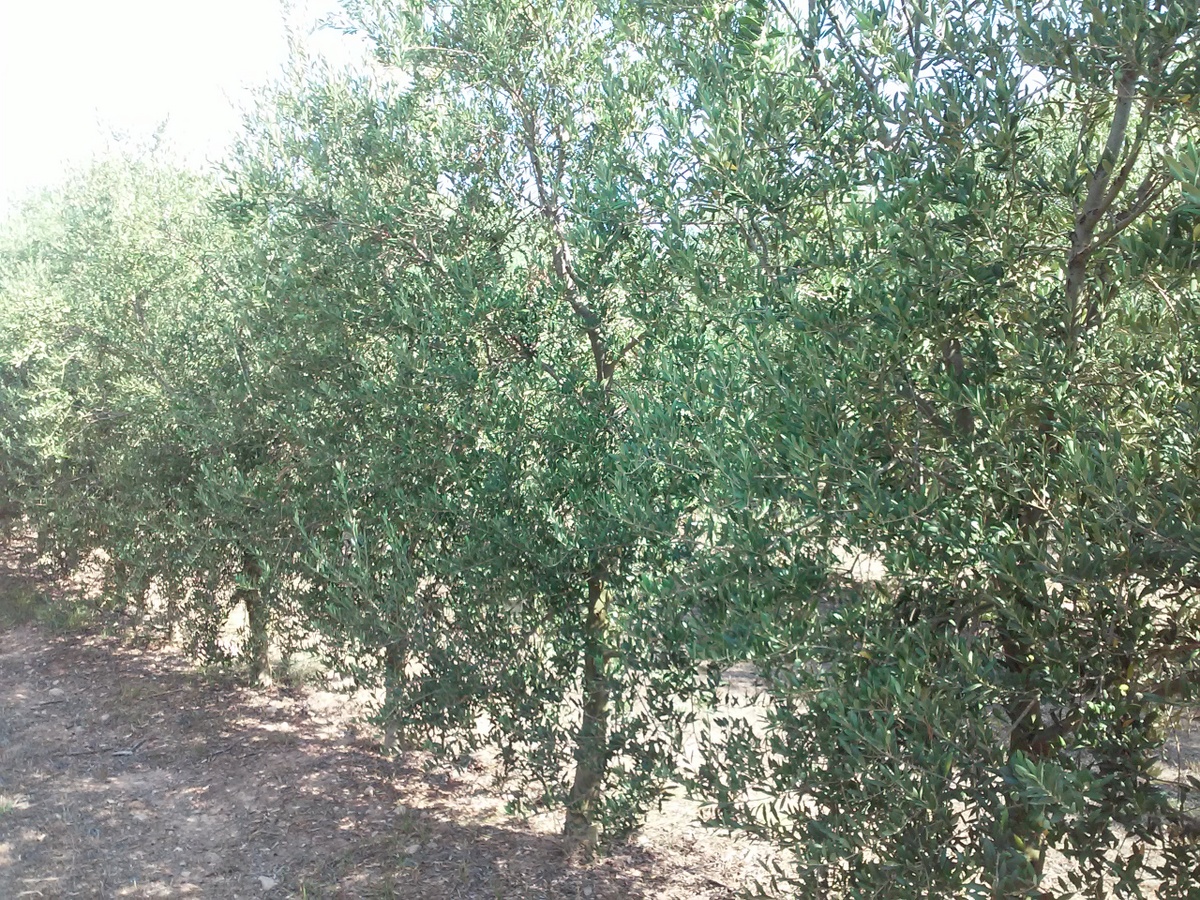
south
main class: Cropland
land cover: Olive groves
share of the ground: 10 - 25 %
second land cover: Other bare soil
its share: > 75 %
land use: Agriculture (excluding fallow land and kitchen gardens)
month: August
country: ES
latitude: 41.0911
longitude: 0.6228
